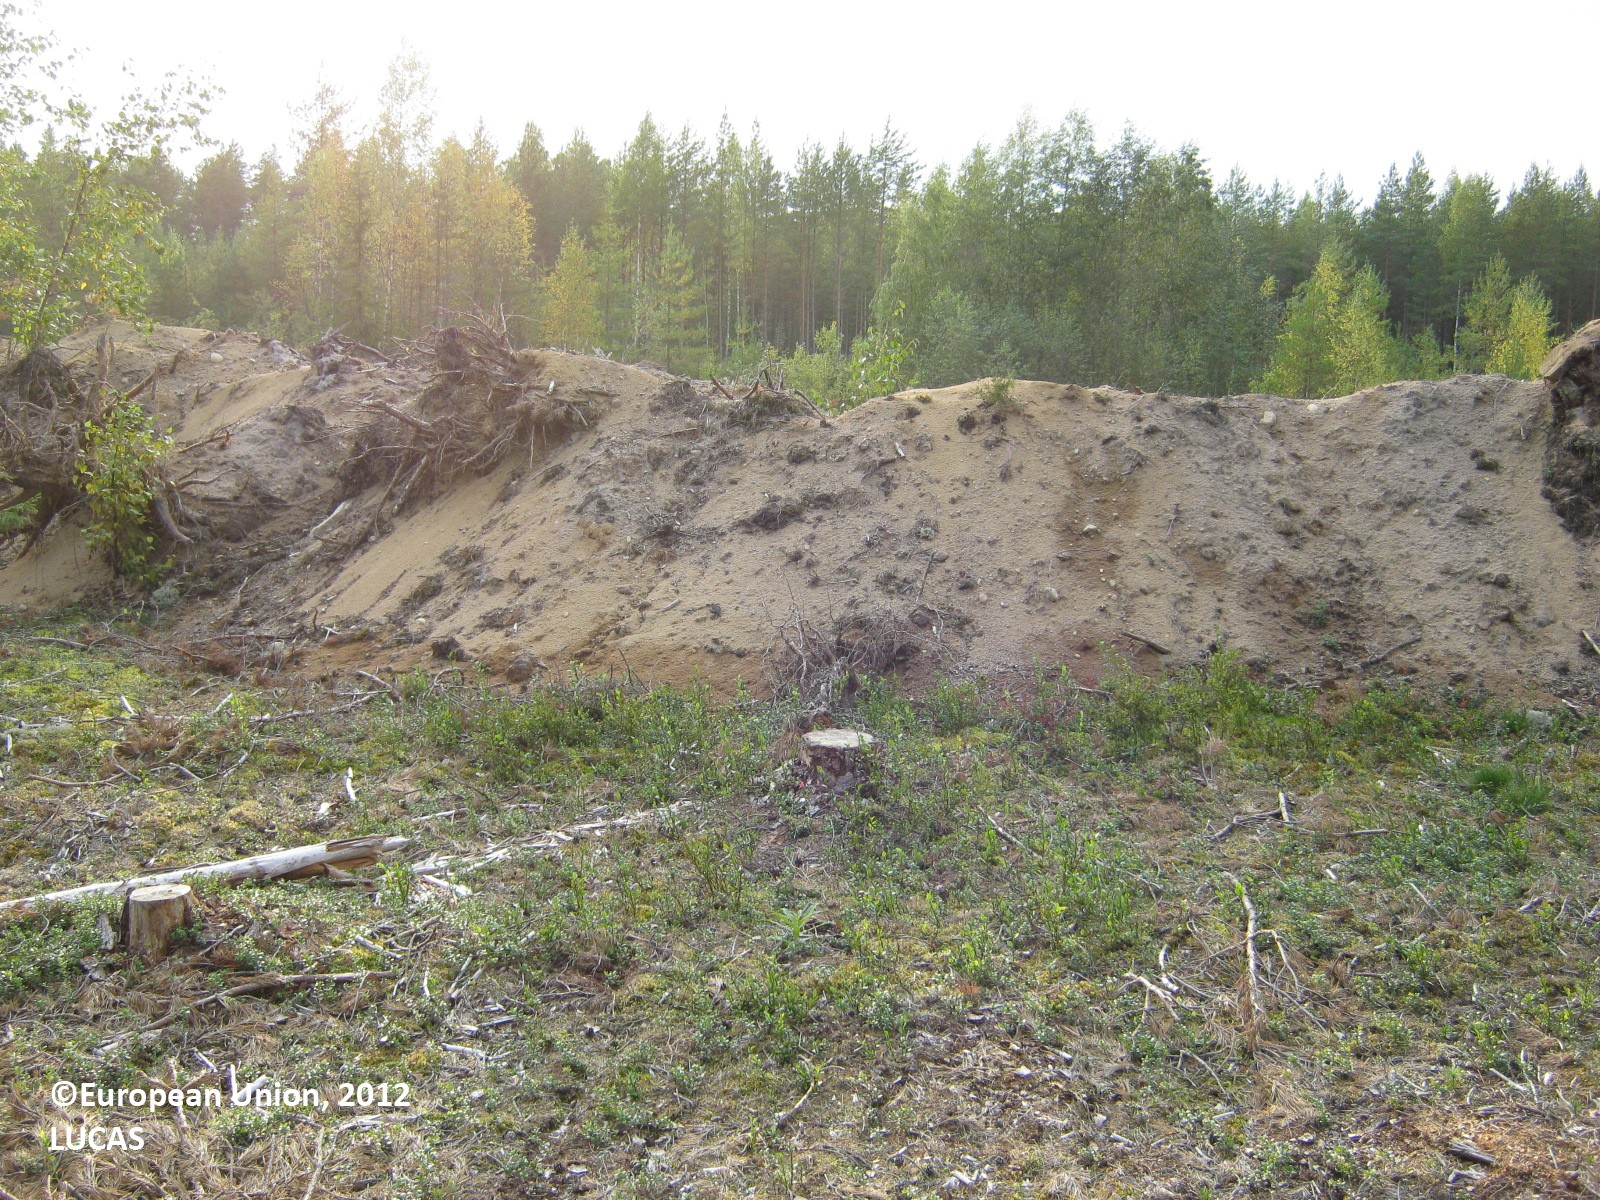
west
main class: Shrubland
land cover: Shrubland with sparse tree cover
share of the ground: > 75 %
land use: Forestry
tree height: < 5 m
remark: Clear cut
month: September
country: FI
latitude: 60.7568
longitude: 28.0965
